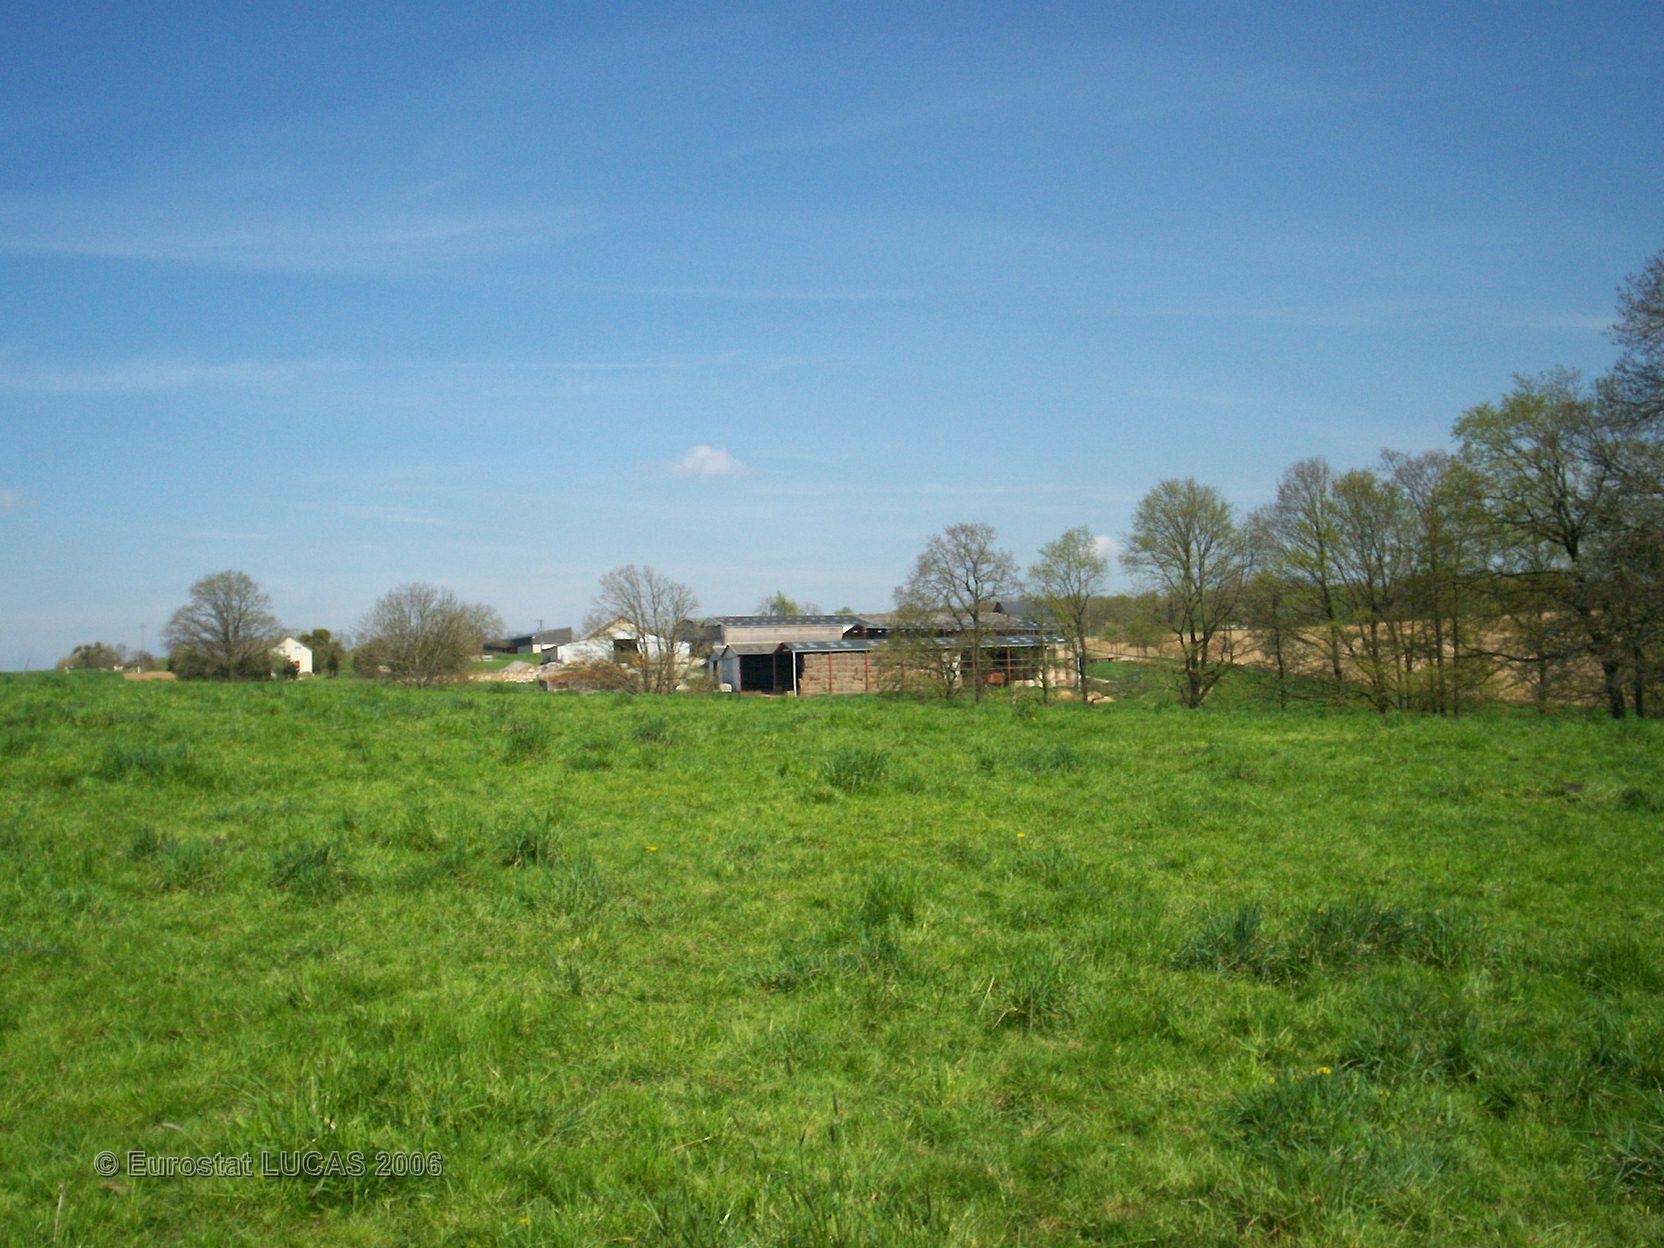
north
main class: Grassland
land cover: Grassland without tree/shrub cover
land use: Agriculture (excluding fallow land and kitchen gardens)
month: April
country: FR
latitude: 49.6508
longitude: 4.4141
